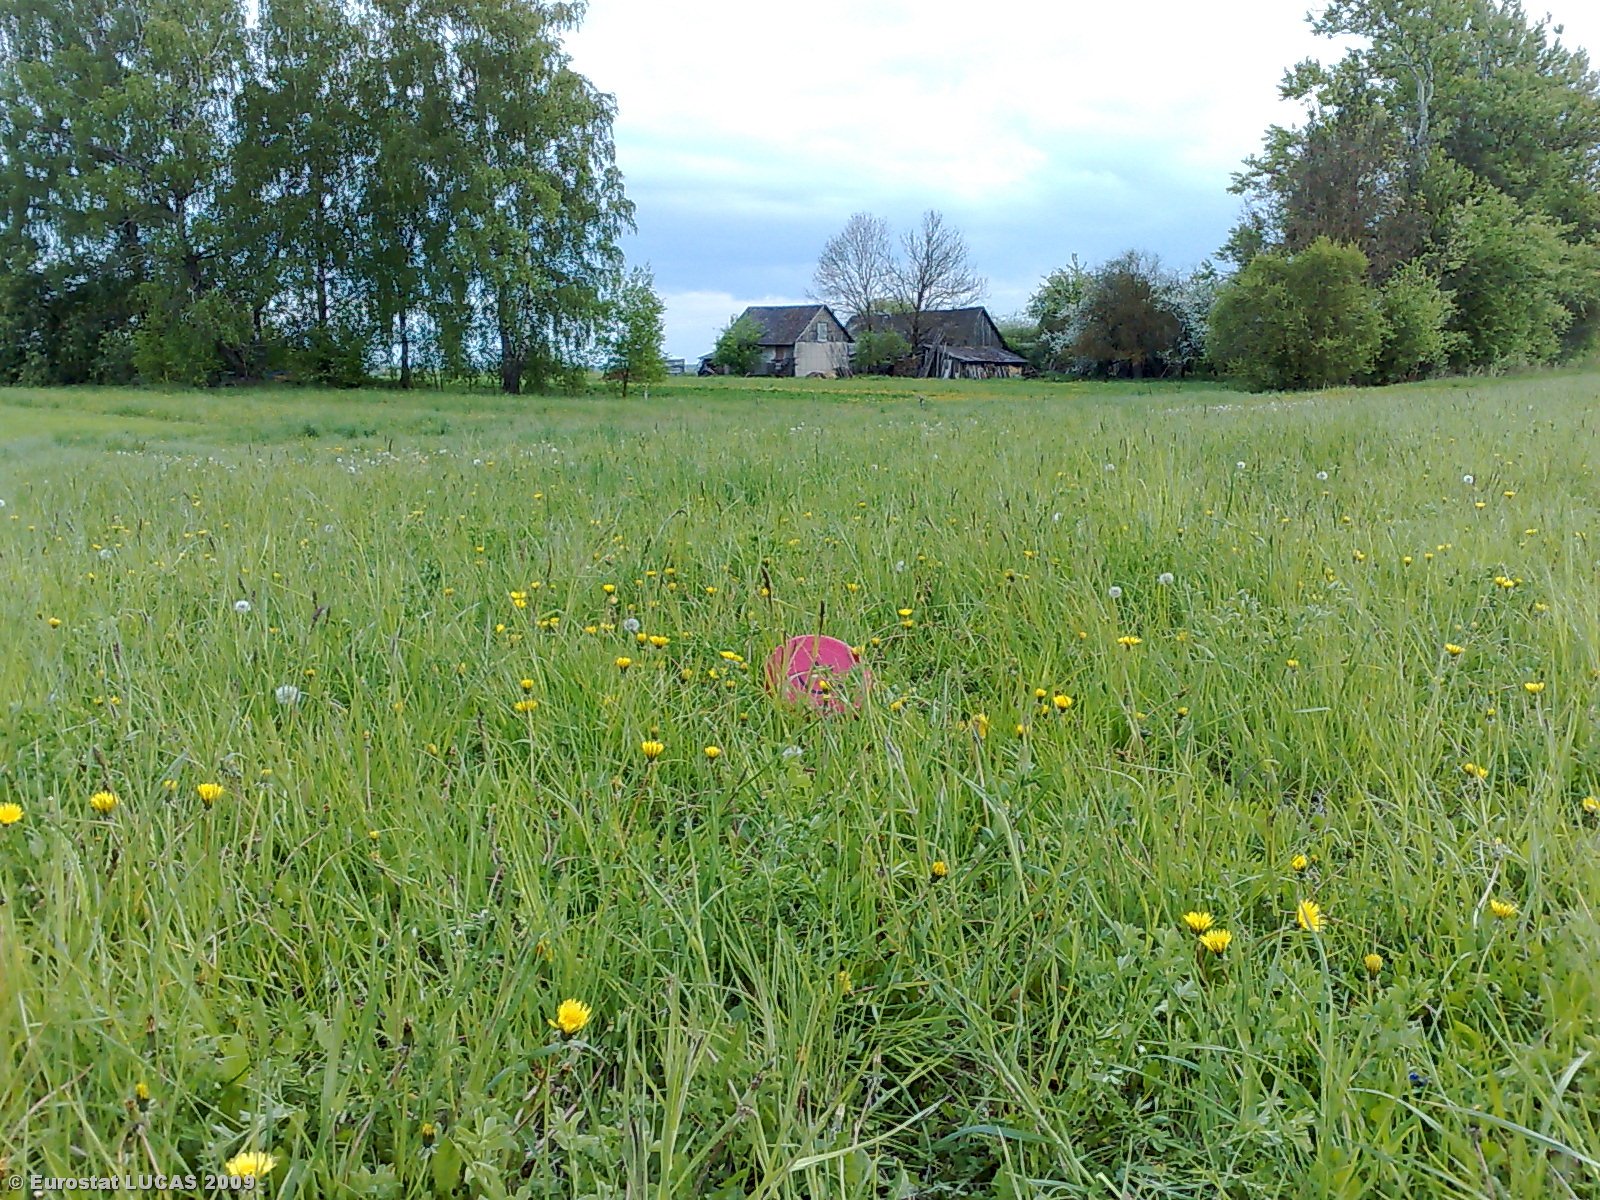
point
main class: Grassland
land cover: Grassland without tree/shrub cover
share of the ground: > 75 %
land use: Agriculture (excluding fallow land and kitchen gardens)
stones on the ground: < 10 %
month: May
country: LT
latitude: 55.6567
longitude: 23.9632
